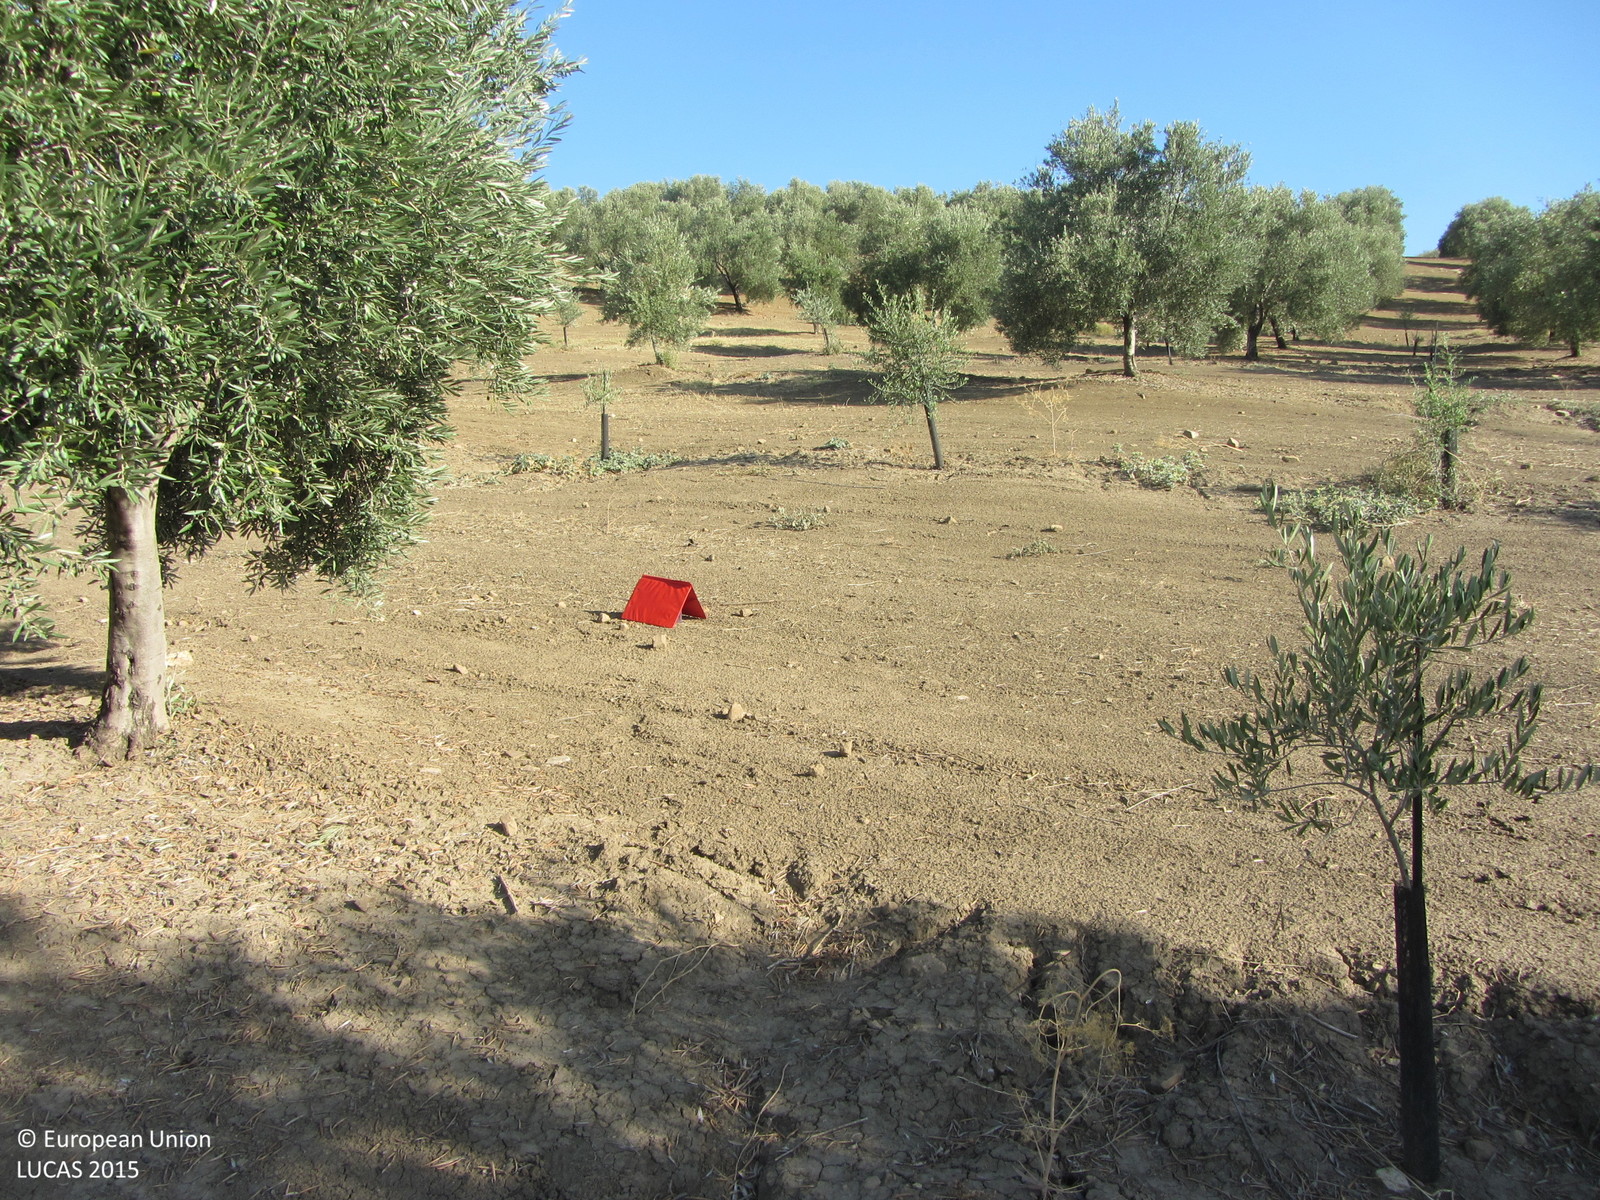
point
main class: Cropland
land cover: Olive groves
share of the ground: 25 - 50 %
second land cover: Other bare soil
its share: > 75 %
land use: Agriculture (excluding fallow land and kitchen gardens)
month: July
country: ES
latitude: 37.9405
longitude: -3.8519
